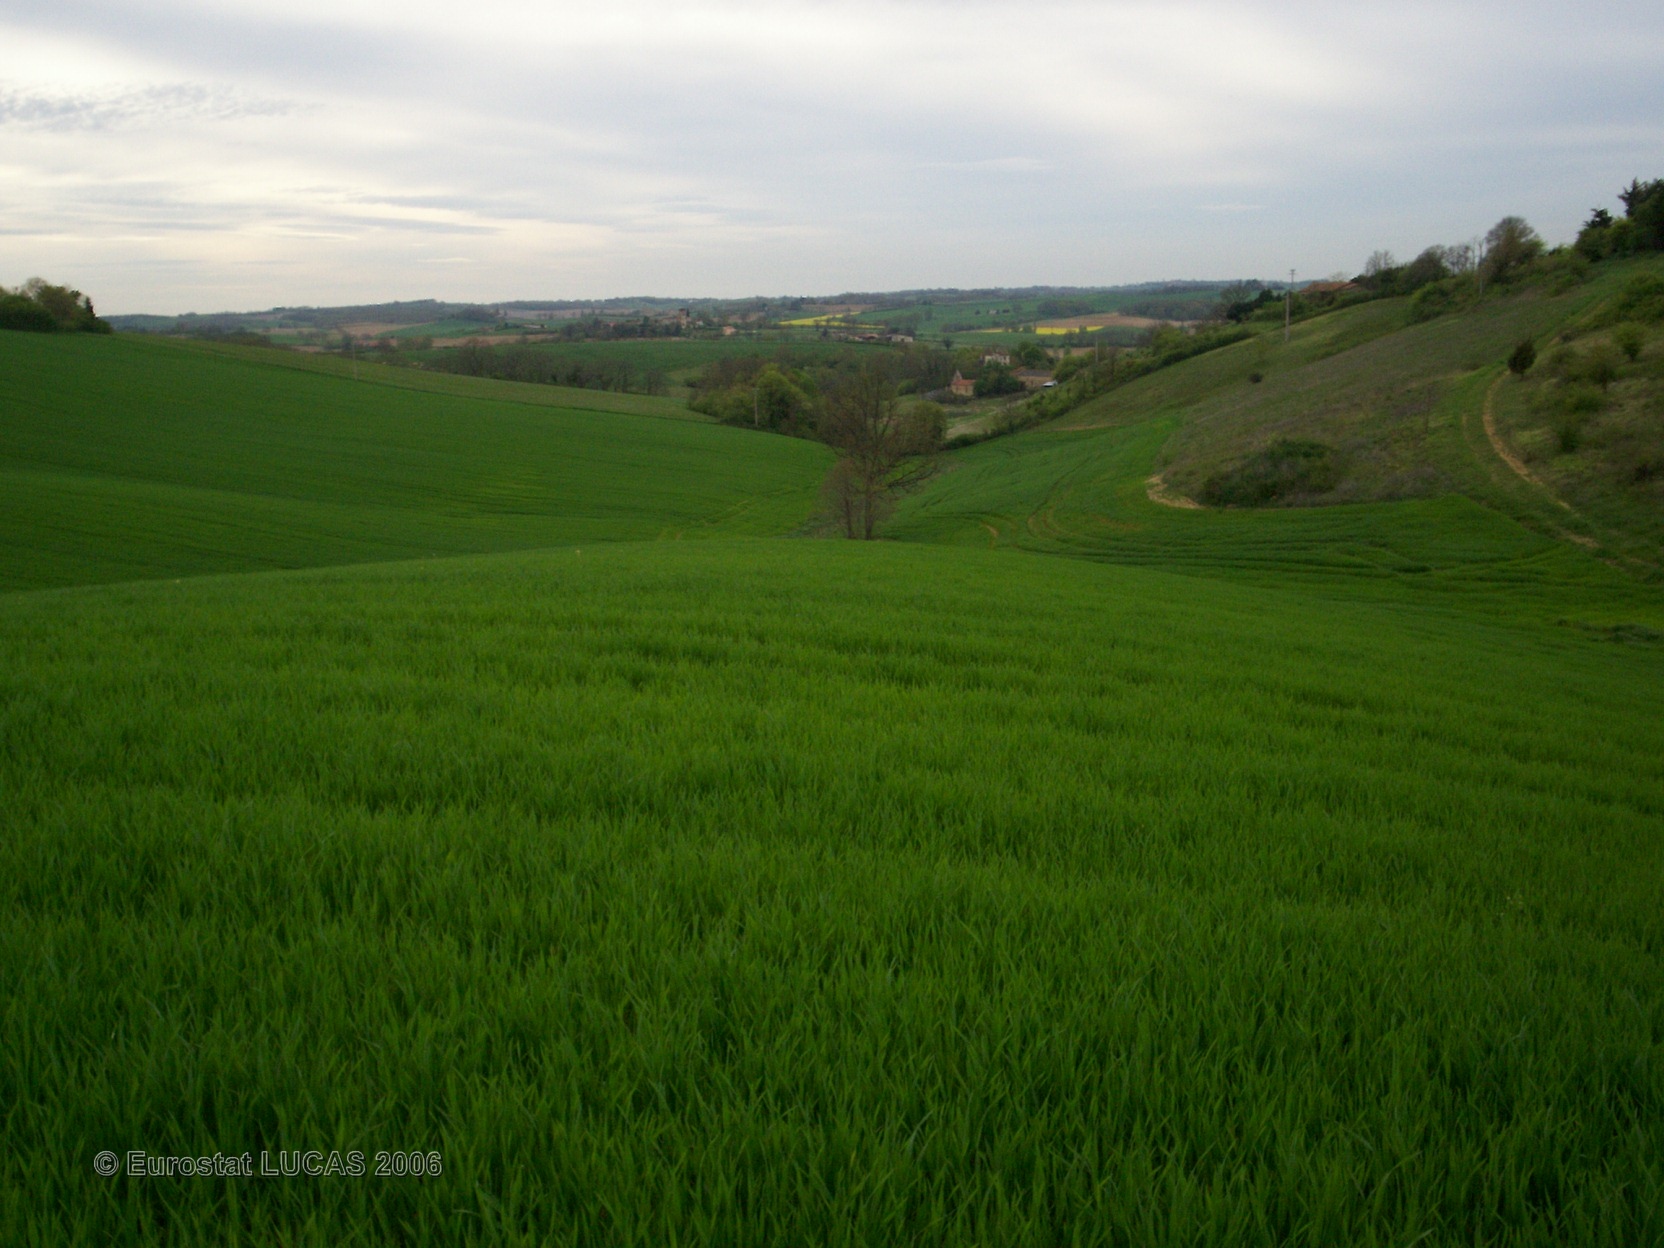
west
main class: Cropland
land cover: Common wheat
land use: Agriculture (excluding fallow land and kitchen gardens)
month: April
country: FR
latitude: 43.6578
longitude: 0.2866
